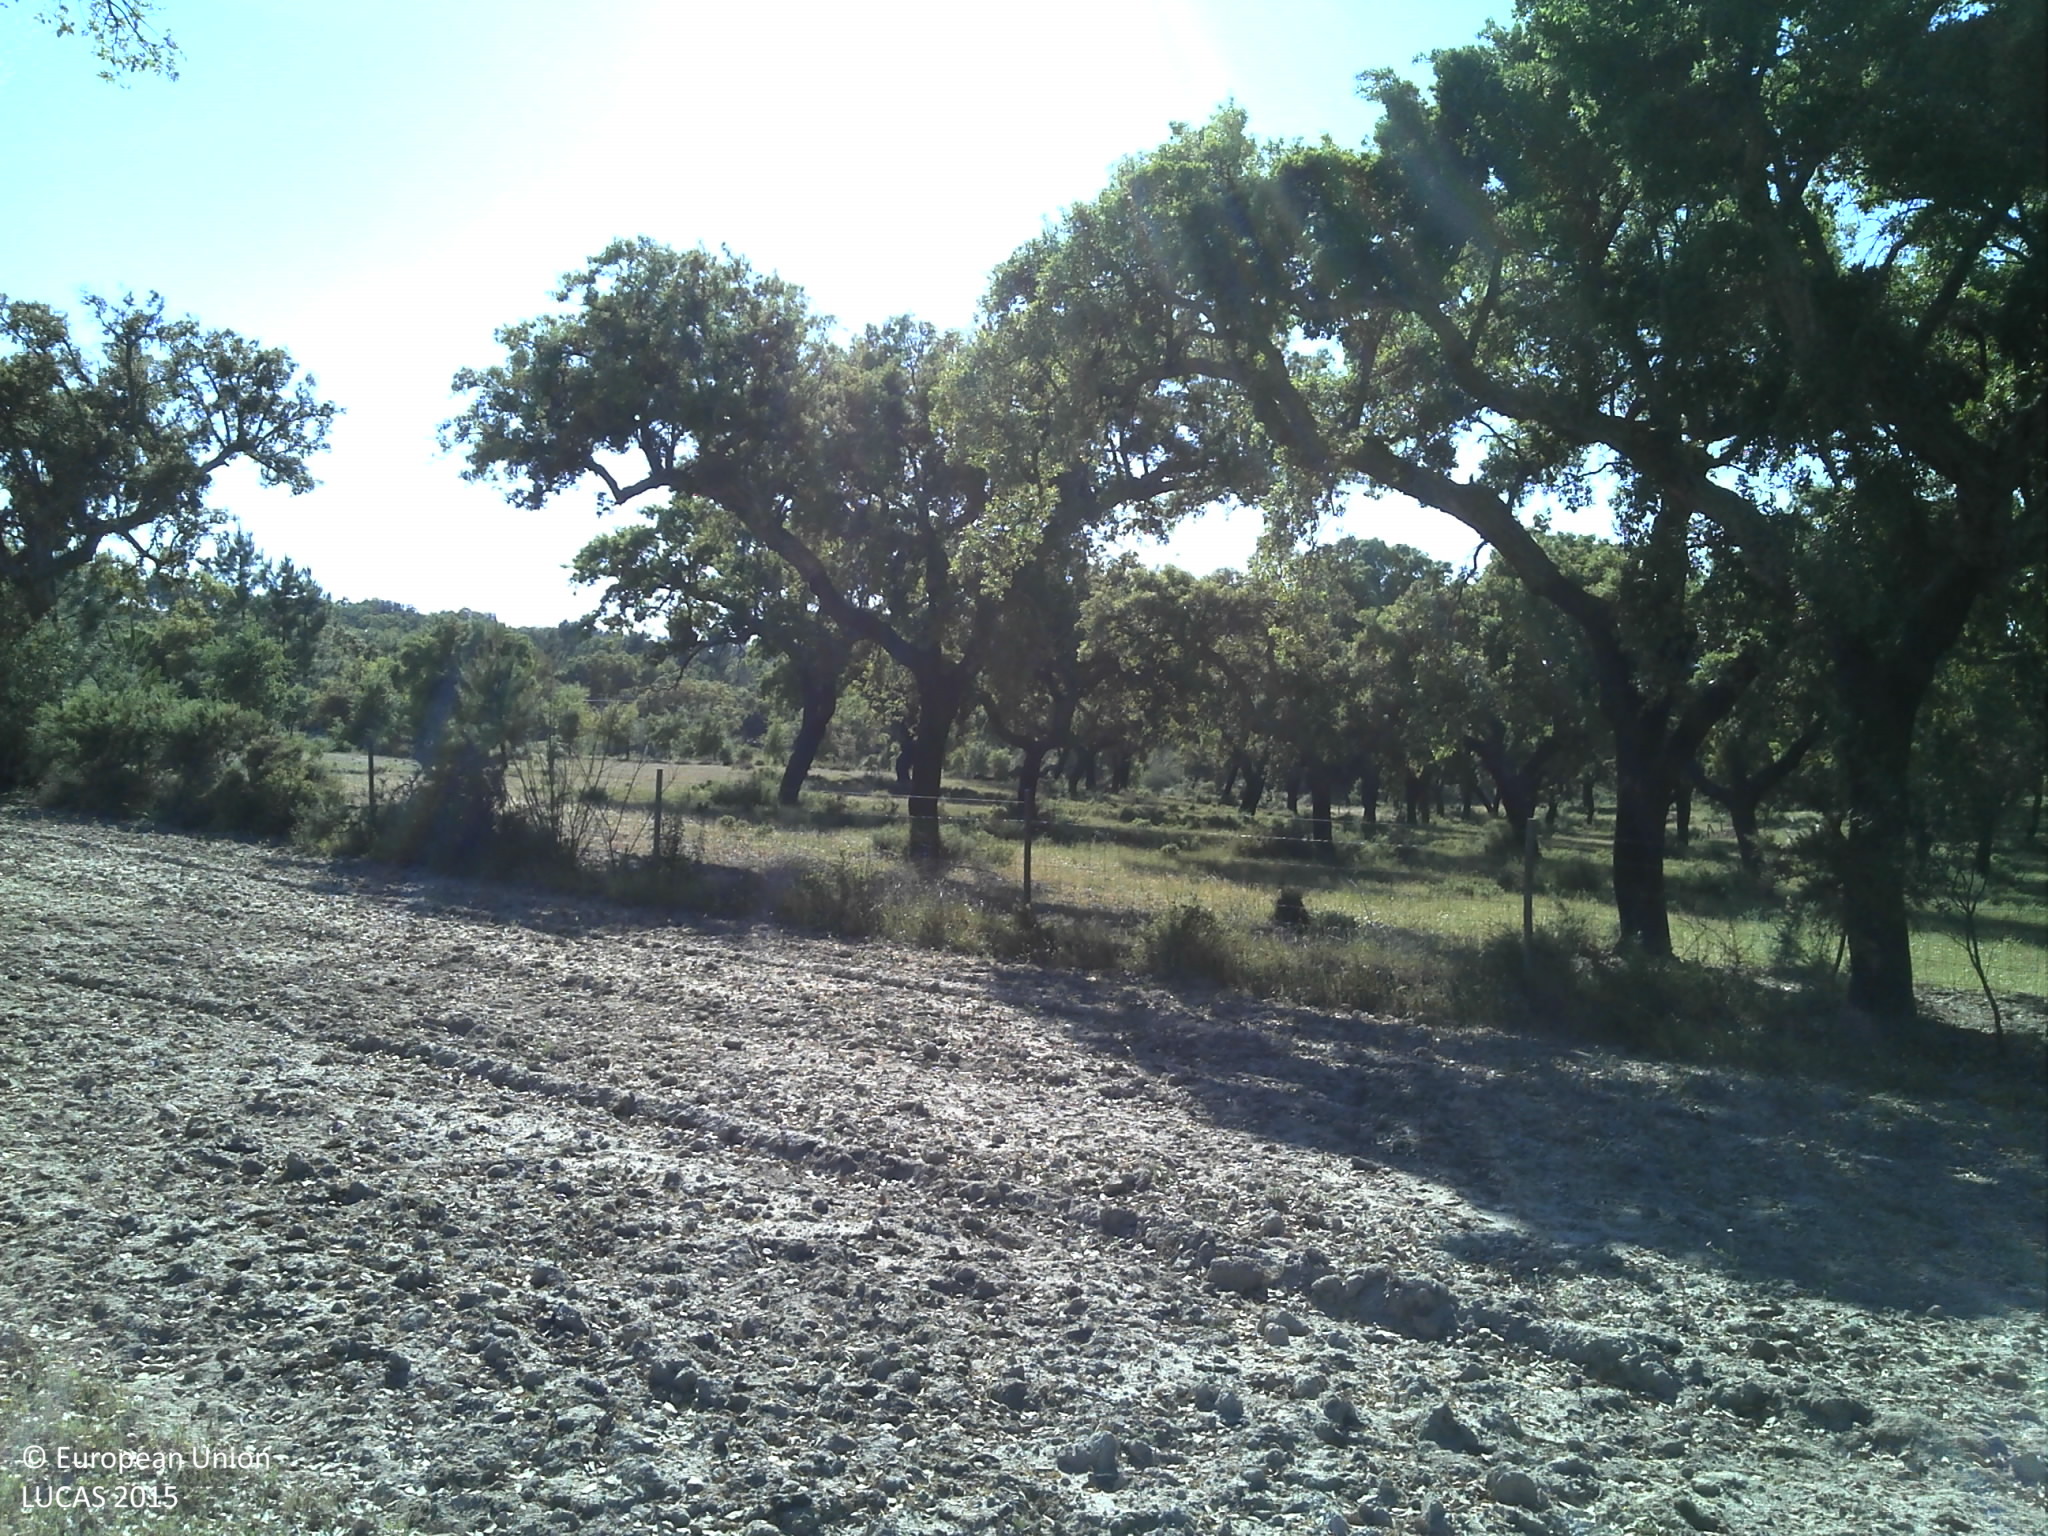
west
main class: Woodland
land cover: Broadleaved woodland
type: broadleaved evergreen forest
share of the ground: 25 - 50 %
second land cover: Grassland without tree/shrub cover
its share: 25 - 50 %
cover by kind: herbaceous plants 40 %, broadleaved forest trees 30 %, unconsolidated bare surface 30 %
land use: Forestry
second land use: Agriculture (excluding fallow land and kitchen gardens)
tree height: > 5 m
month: May
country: PT
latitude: 39.2425
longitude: -7.9542
